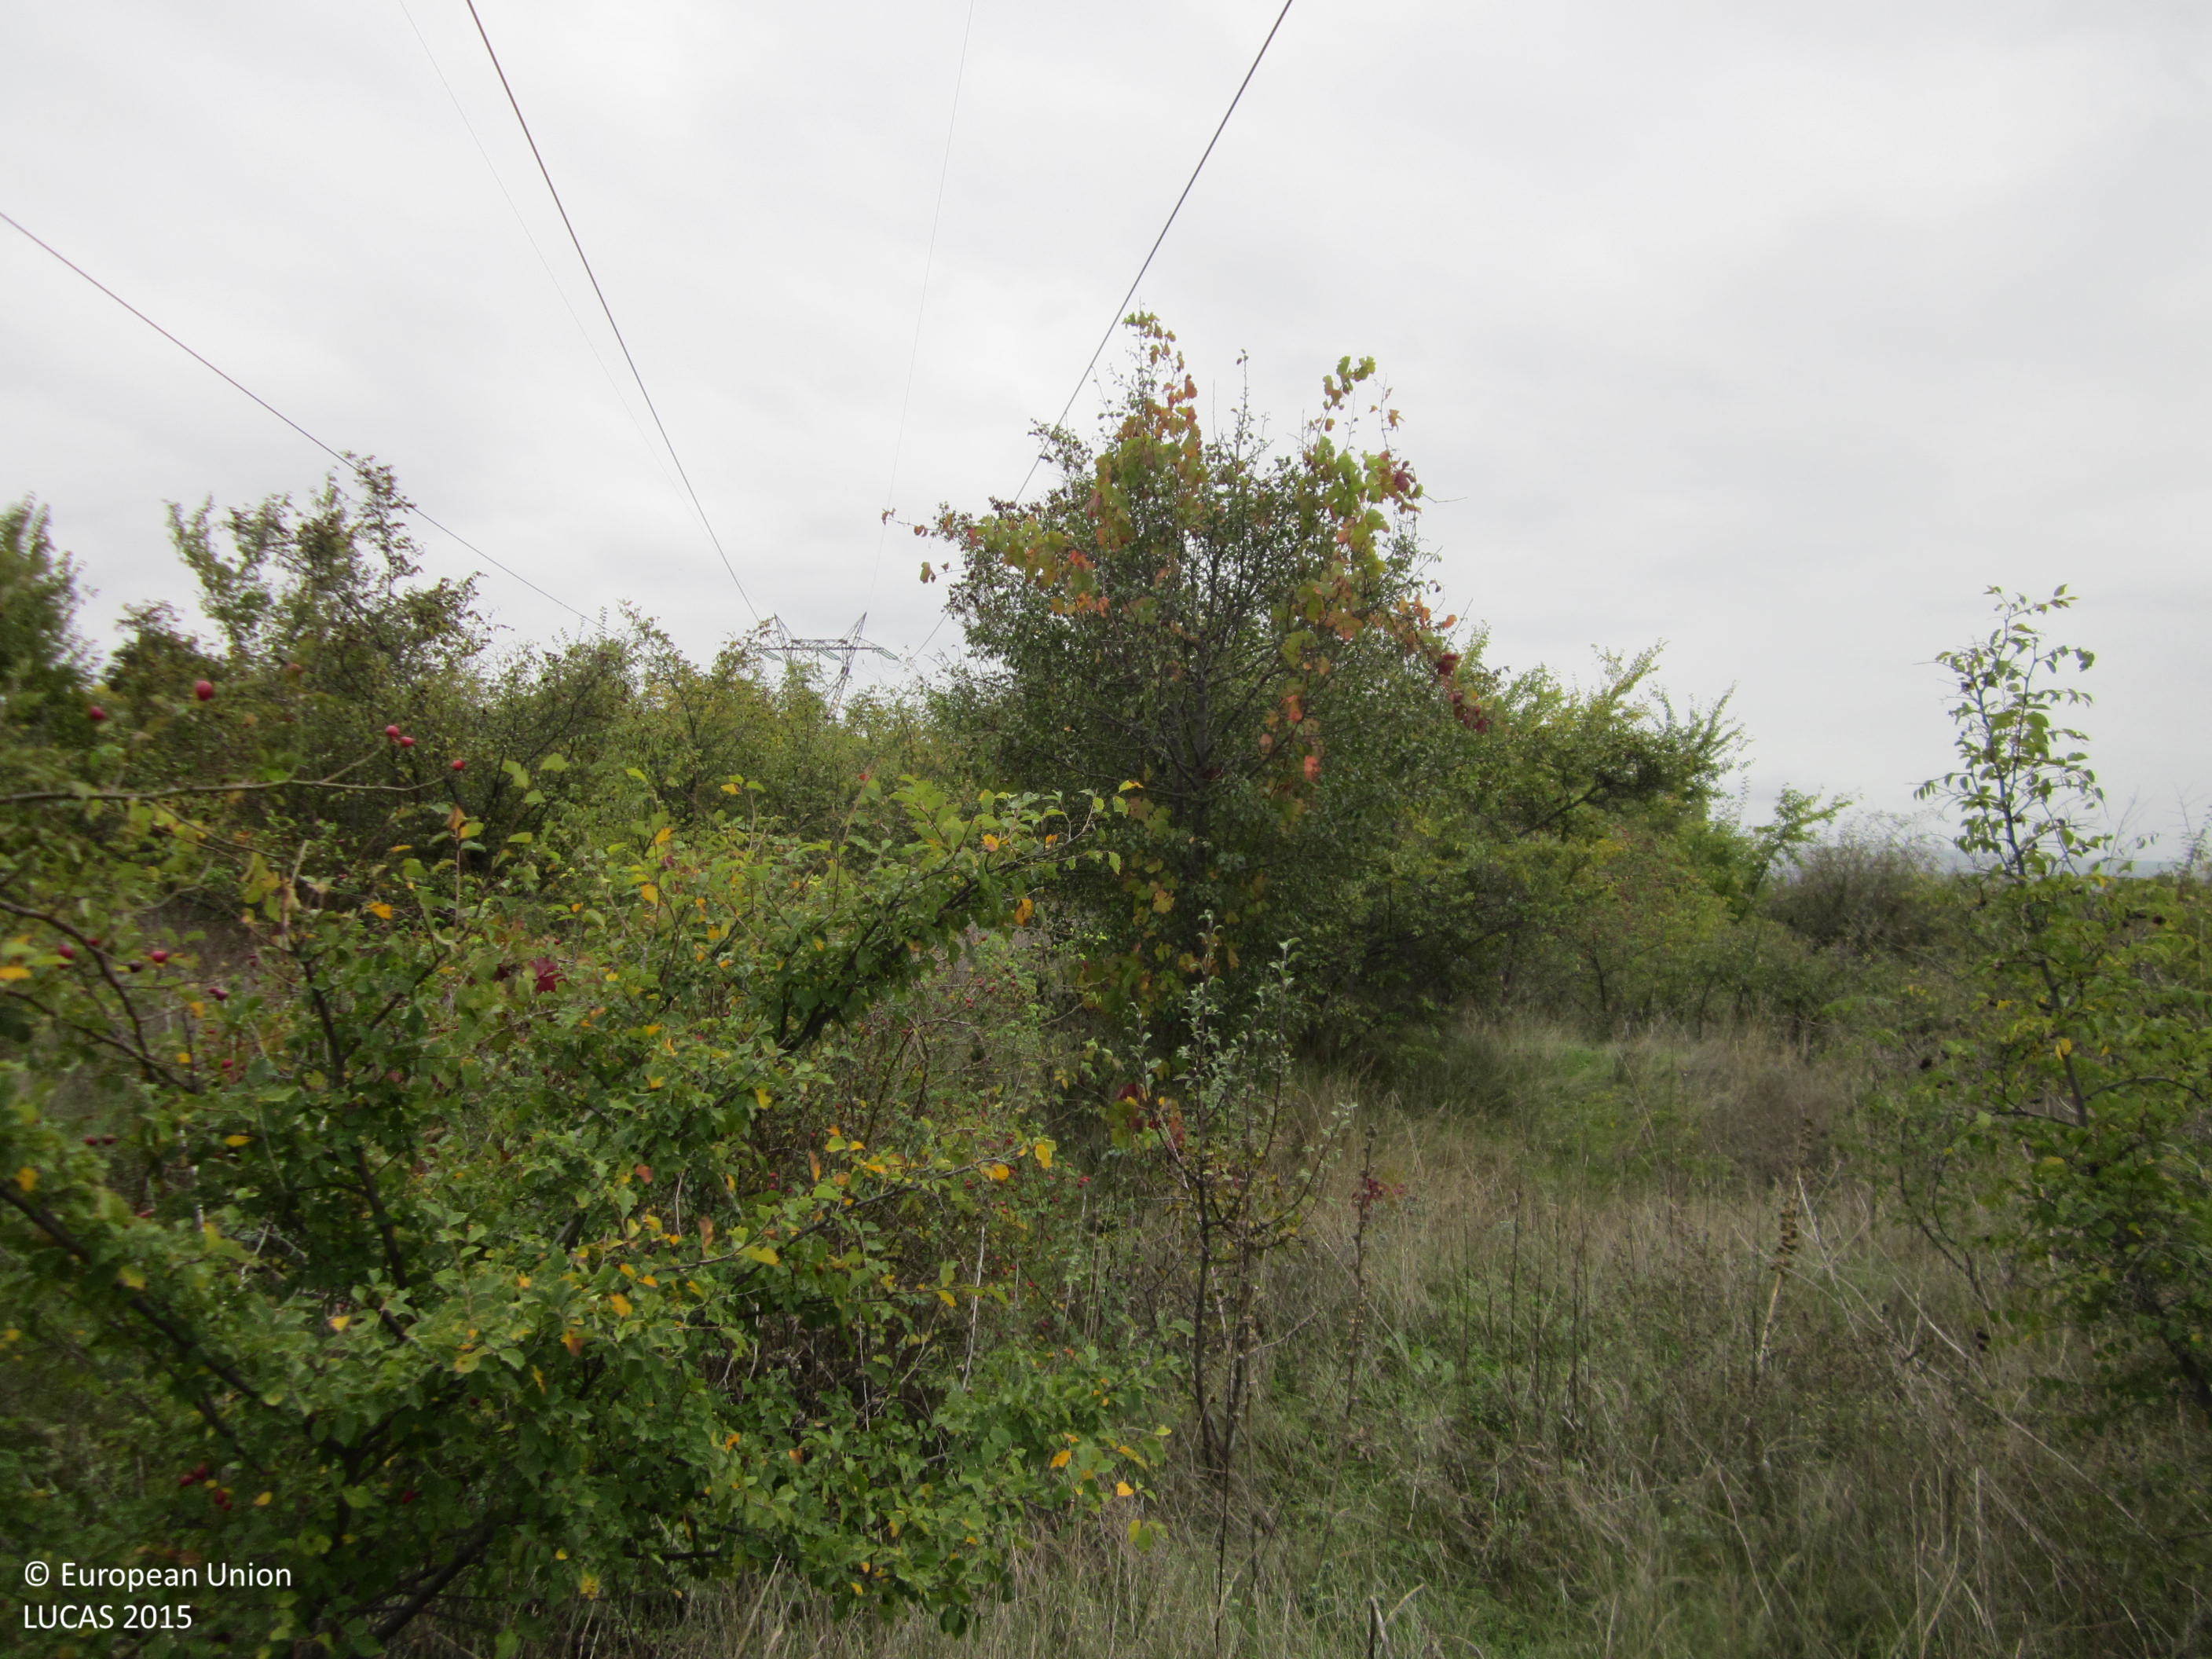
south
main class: Shrubland
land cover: Shrubland with sparse tree cover
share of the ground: > 75 %
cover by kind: shrubs 90 %, broadleaved forest trees 5 %, herbaceous plants 5 %
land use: Semi-natural and natural areas not in use
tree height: > 5 m
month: October
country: BG
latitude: 42.7422
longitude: 27.0525
